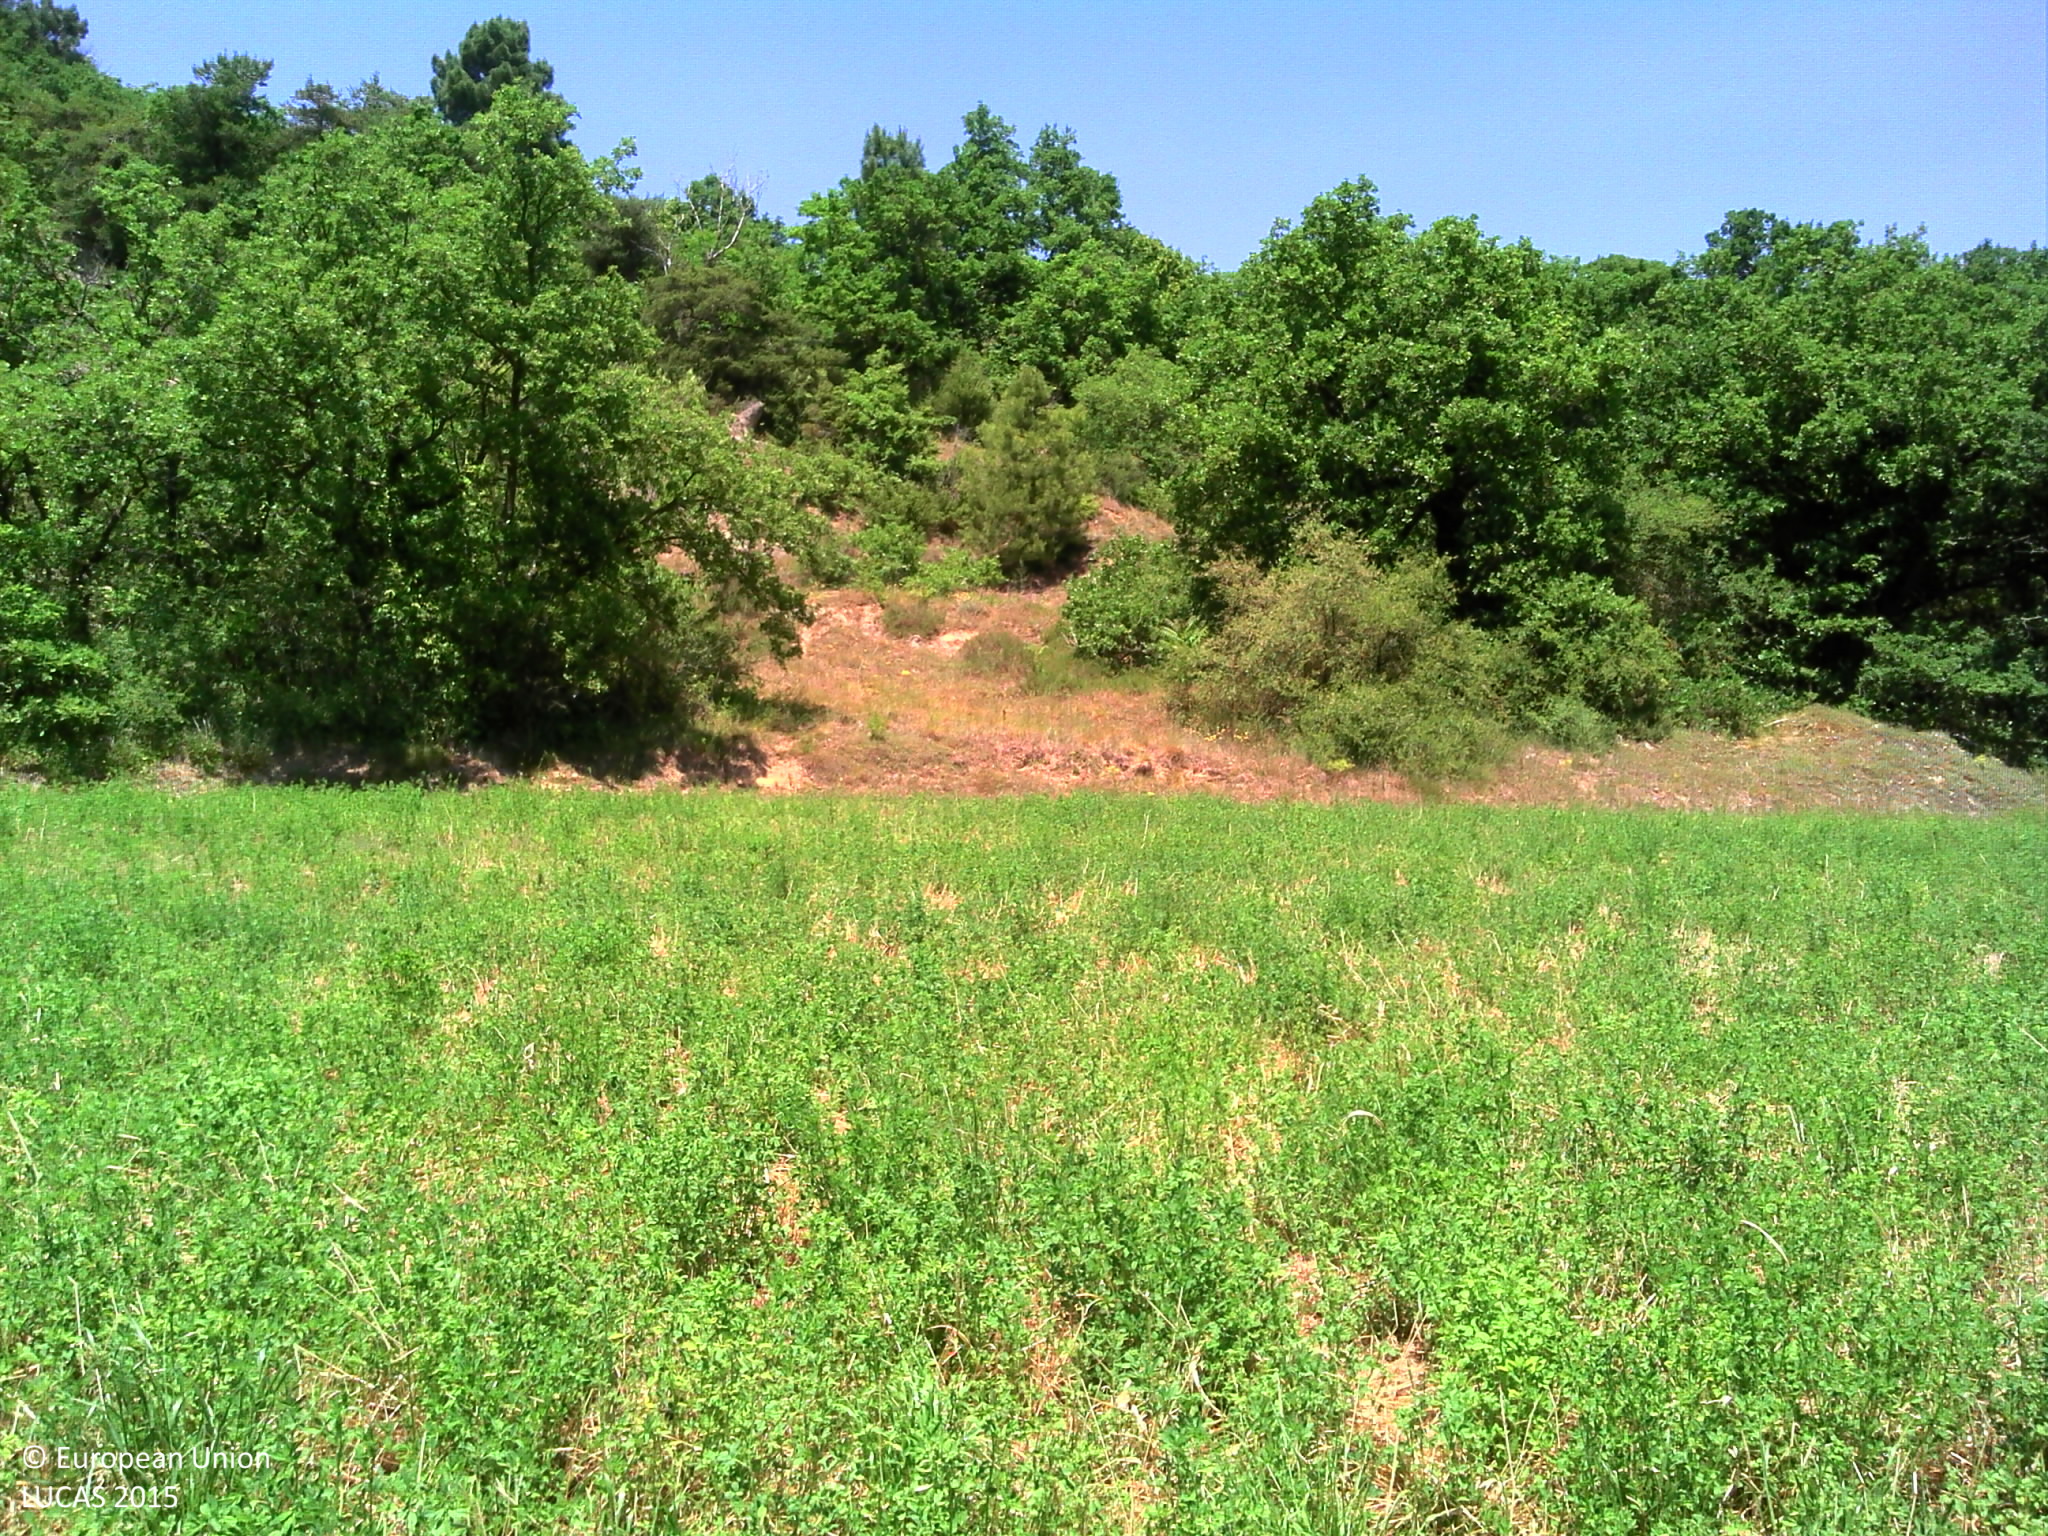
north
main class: Cropland
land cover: Lucerne
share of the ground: > 75 %
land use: Agriculture (excluding fallow land and kitchen gardens)
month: May
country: FR
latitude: 45.0617
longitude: 5.0146
